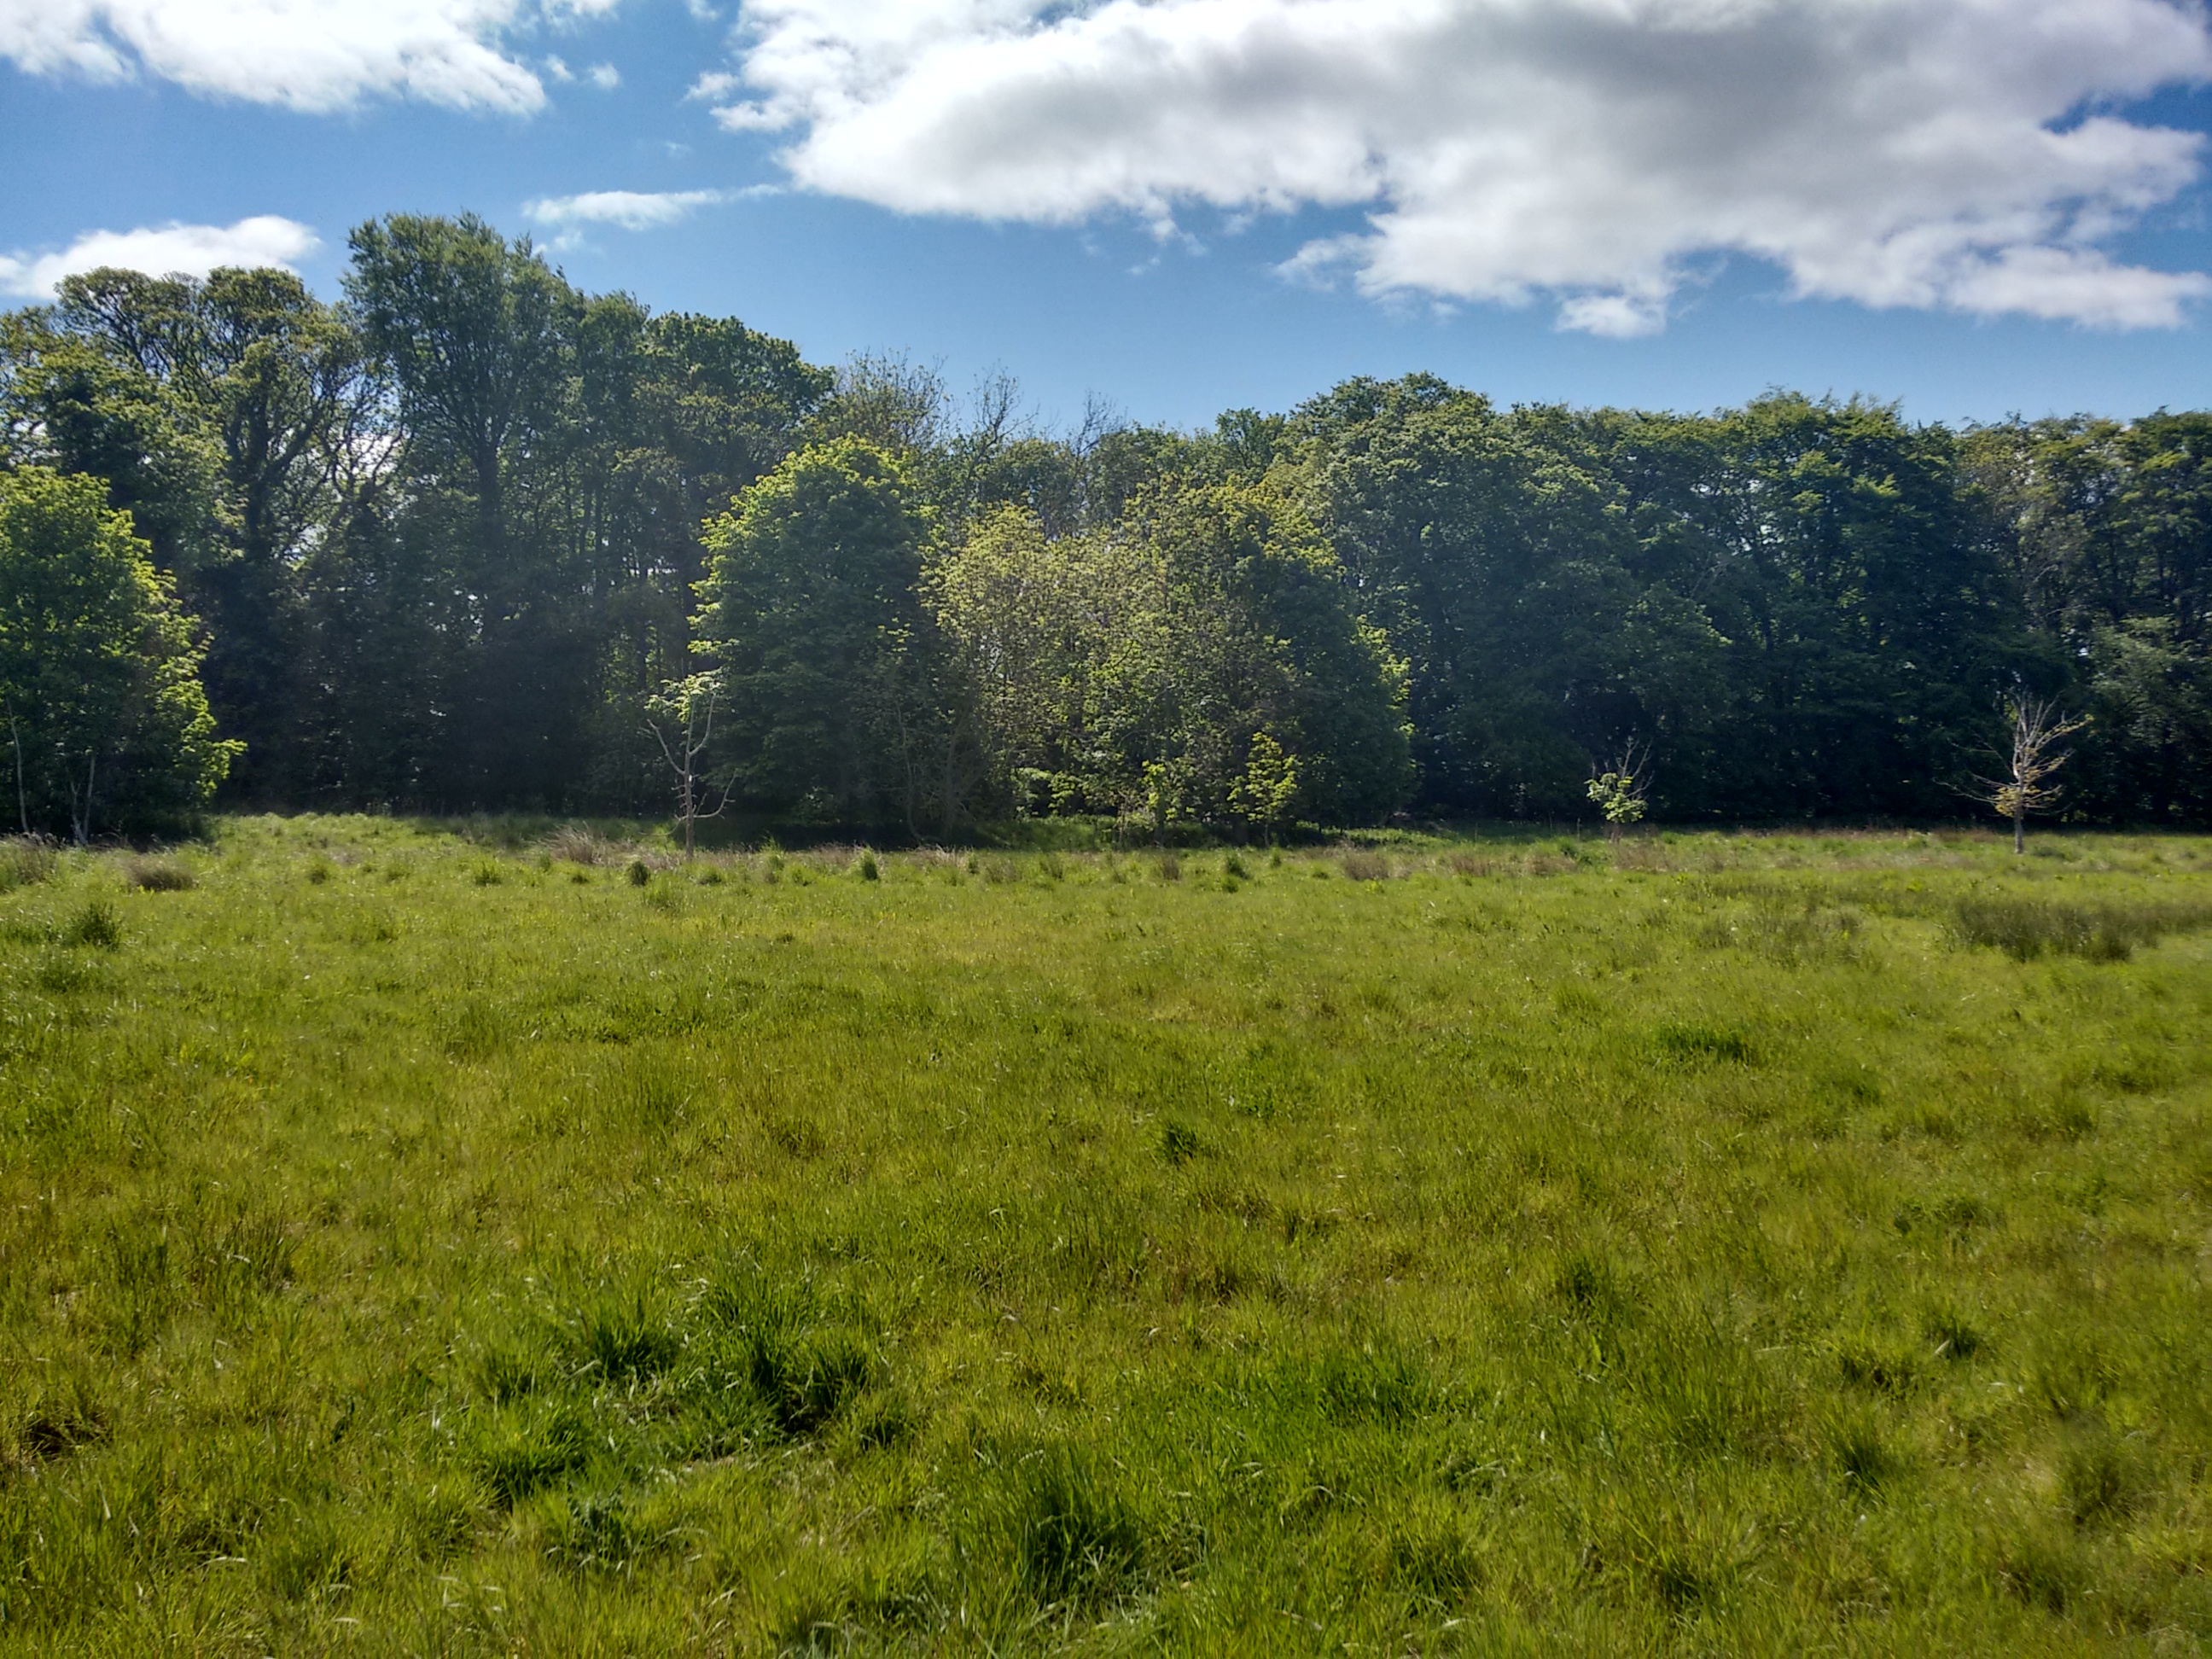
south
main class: Grassland
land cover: Grassland without tree/shrub cover
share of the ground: > 75 %
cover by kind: herbaceous plants 100 %
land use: Agriculture (excluding fallow land and kitchen gardens)
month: May
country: GB
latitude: 56.0124
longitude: -2.8489
